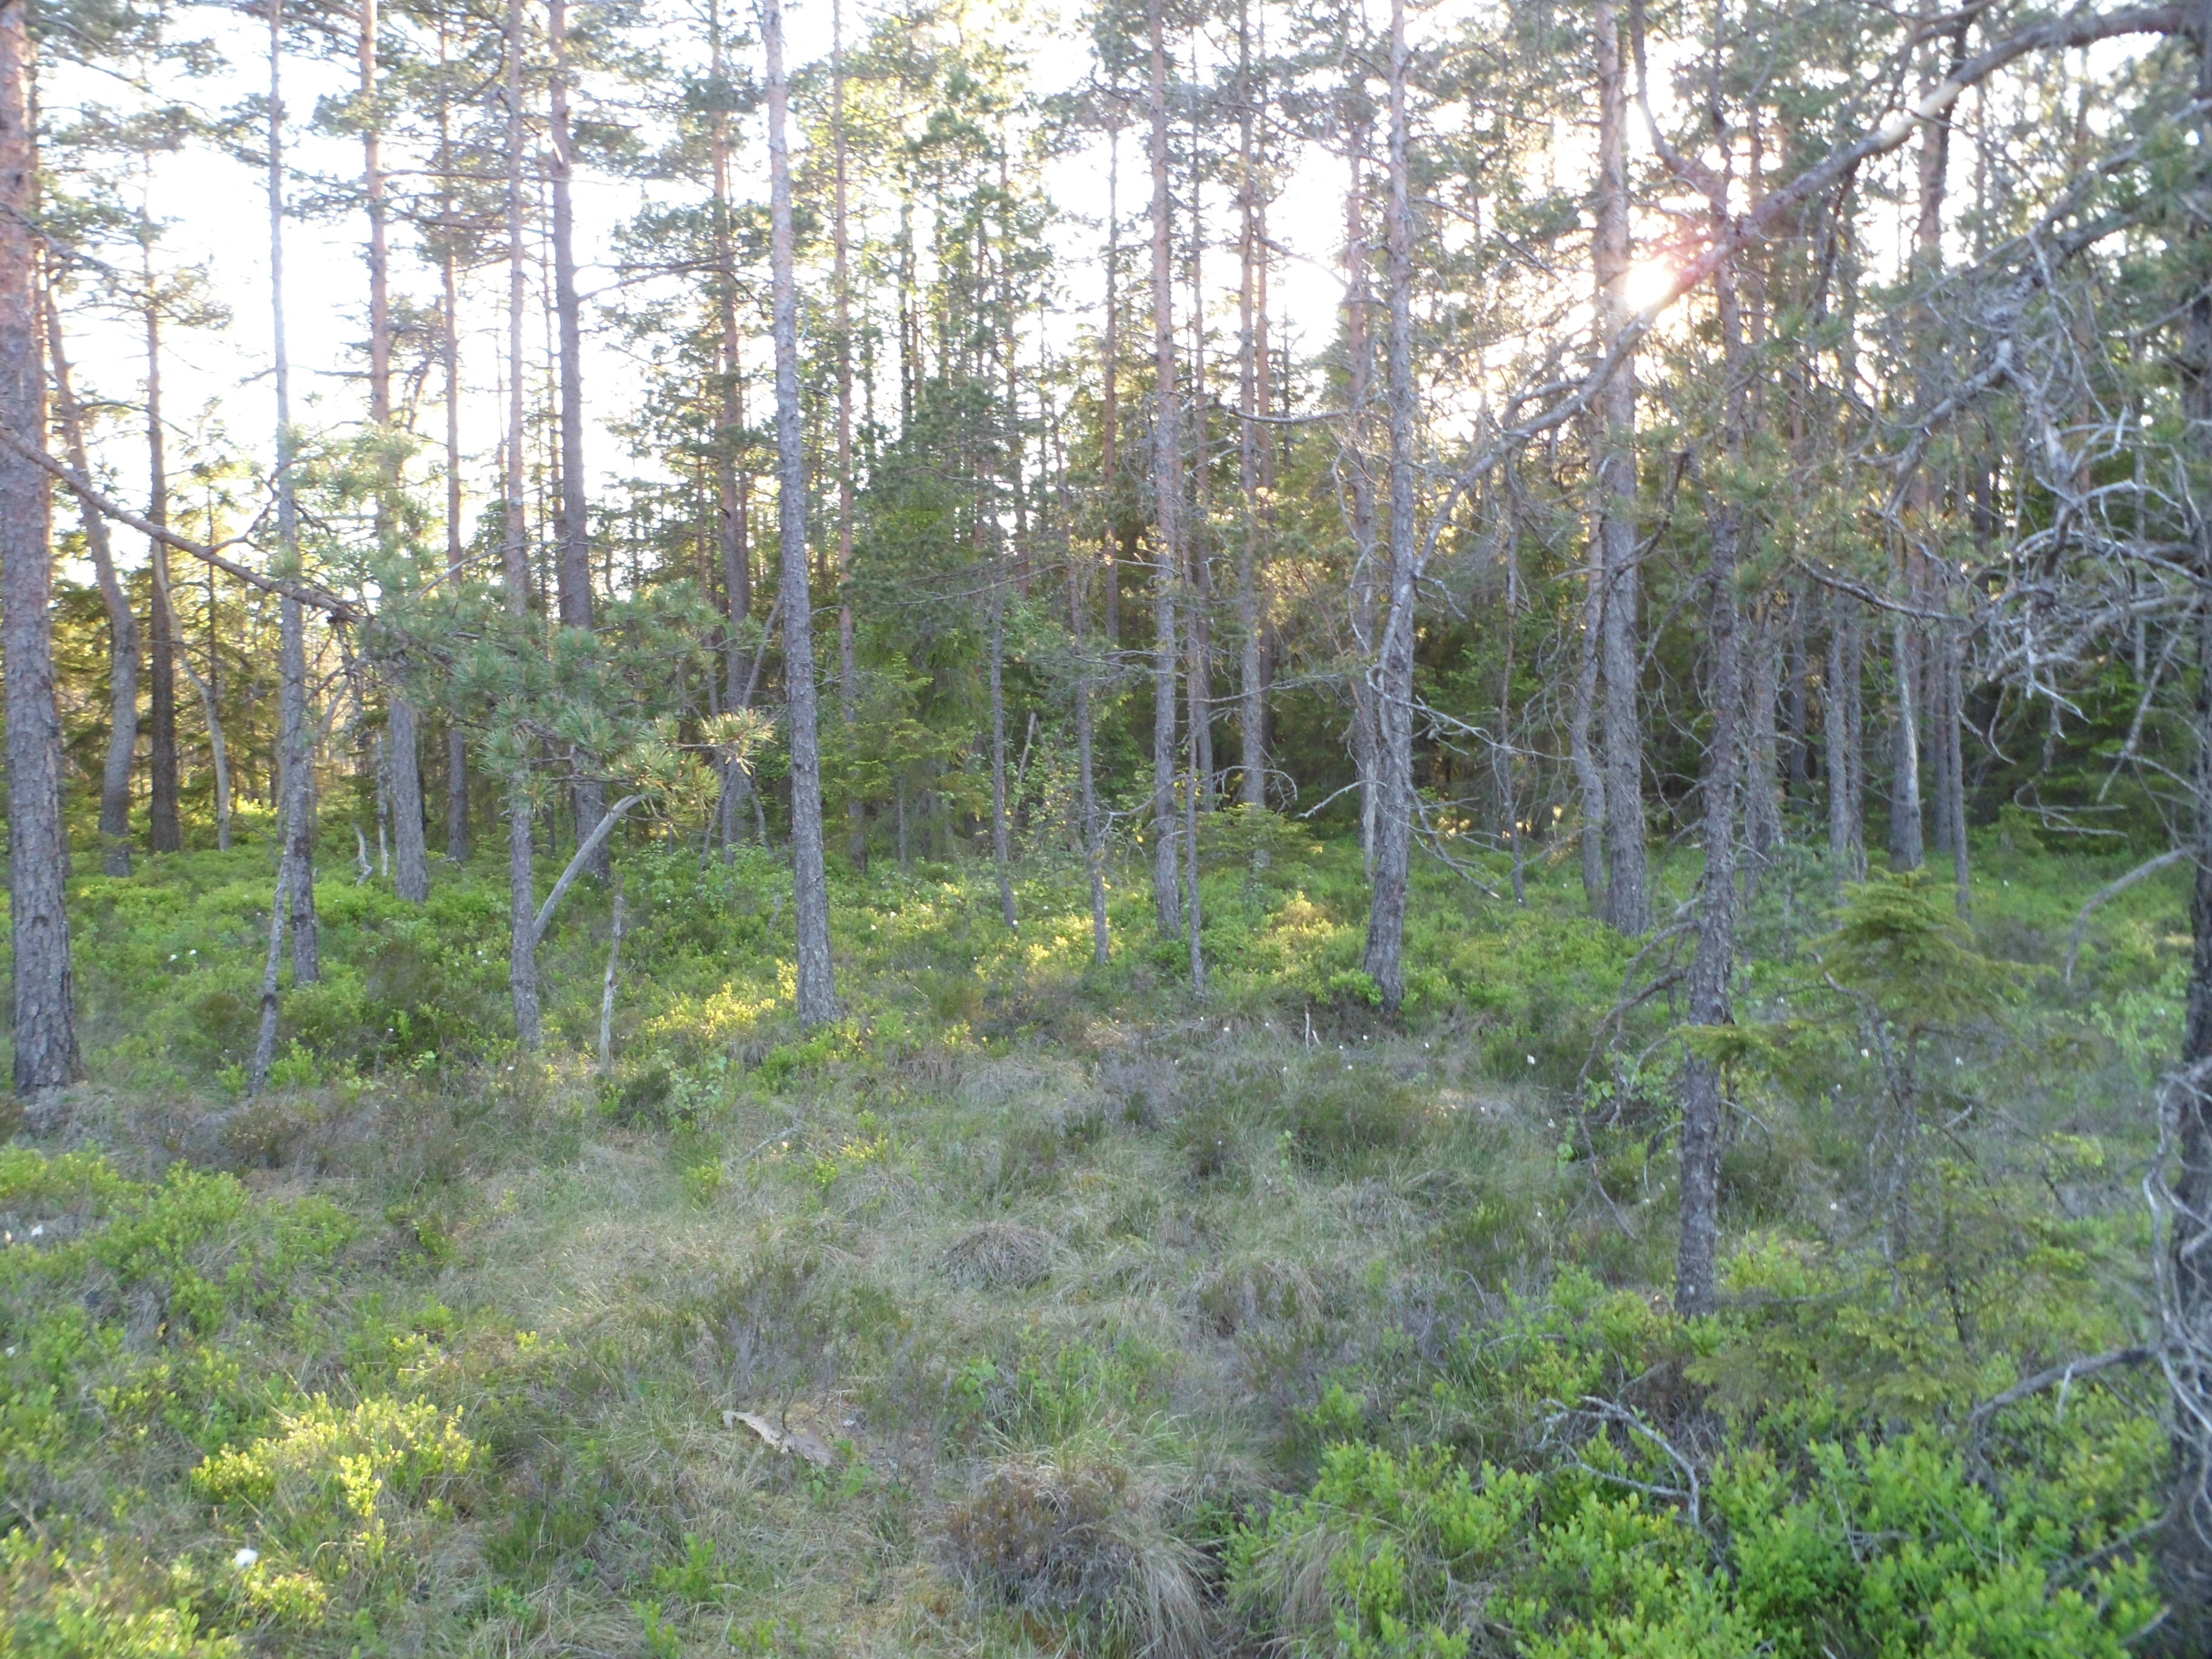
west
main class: Woodland
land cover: Pine dominated coniferous woodland
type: boreal forest
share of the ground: 25 - 50 %
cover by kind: coniferous forest trees 30 %, herbaceous plants 25 %, lichens and mosses 25 %, shrubs 20 %
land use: Forestry
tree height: > 5 m
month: June
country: SE
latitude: 57.5501
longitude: 13.9223
